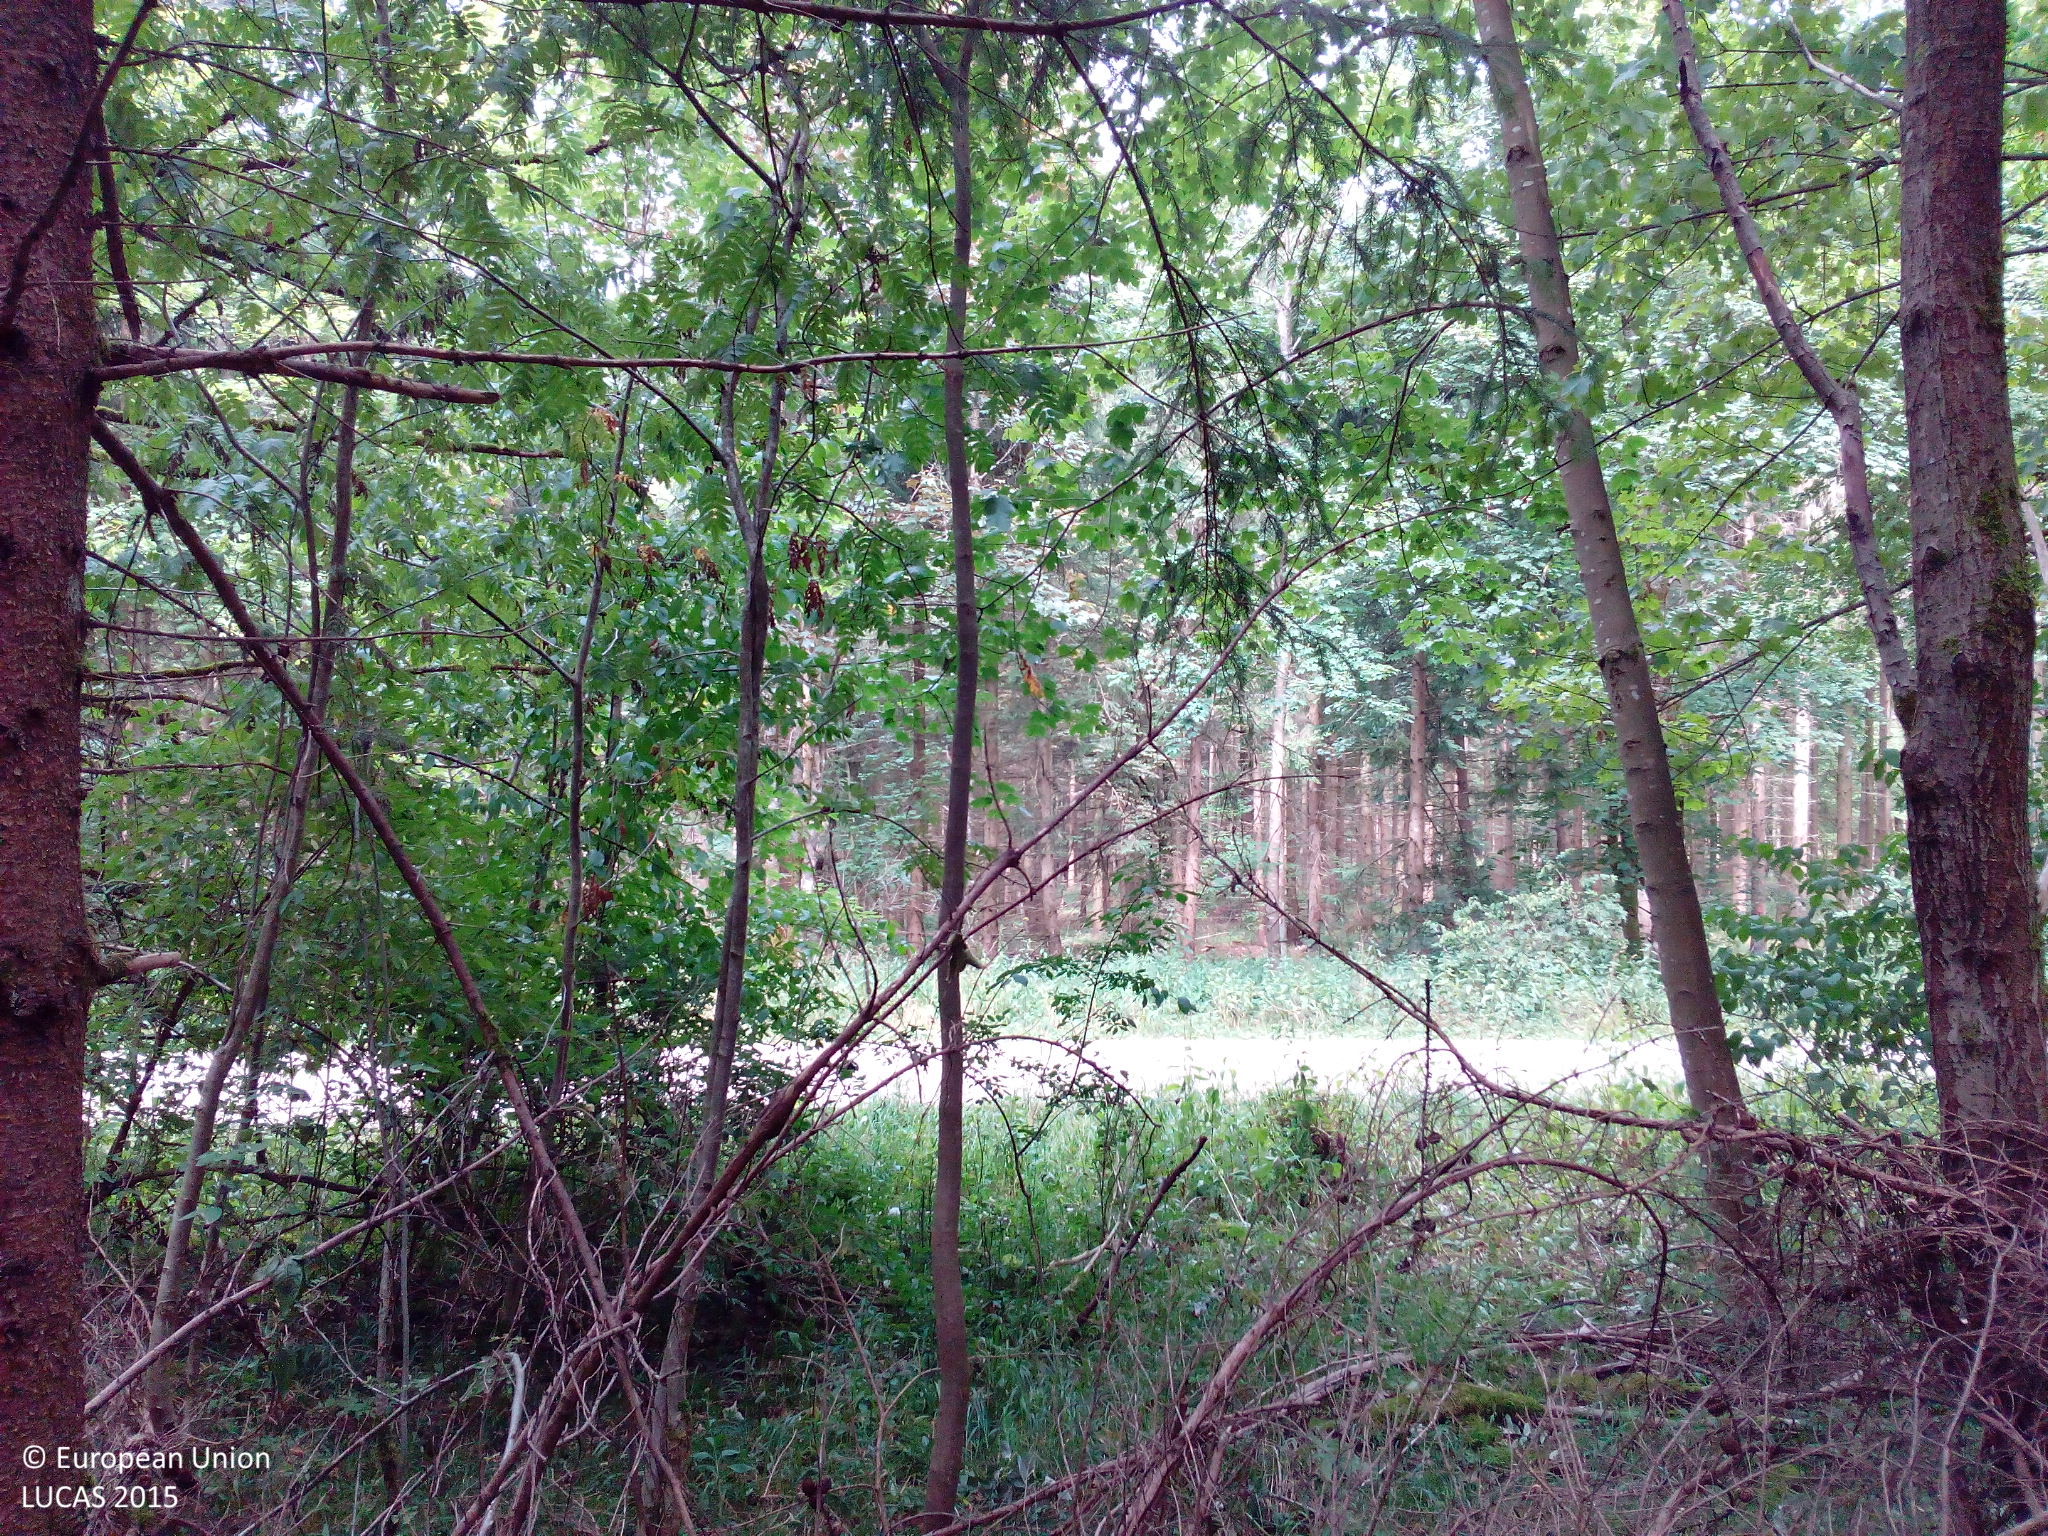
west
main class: Woodland
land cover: Spruce dominated mixed woodland
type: hemiboreal forest and nemoral coniferous forest and mixed broadleaved-coniferous forest
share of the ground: > 75 %
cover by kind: coniferous forest trees 45 %, broadleaved forest trees 30 %, lichens and mosses 15 %, shrubs 5 %, herbaceous plants 5 %
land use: Forestry
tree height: > 5 m
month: July
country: DE
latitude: 48.8169
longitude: 10.3131
